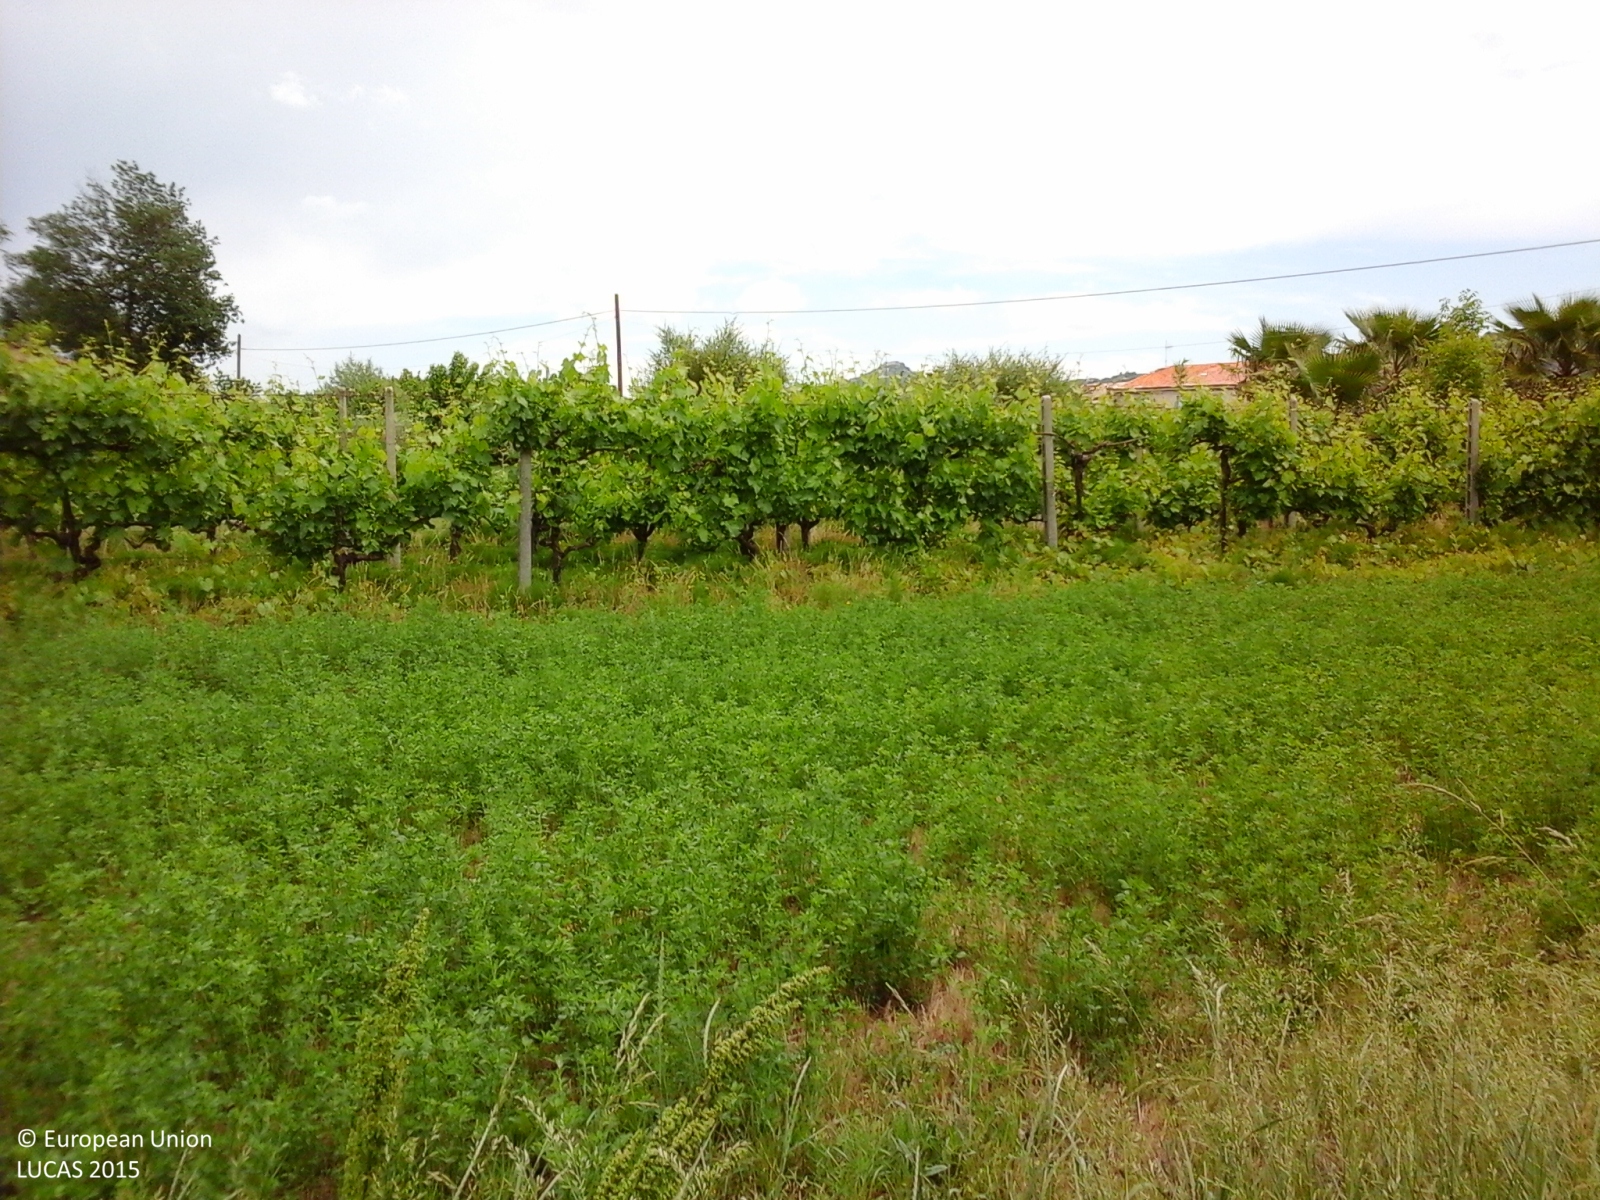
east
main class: Cropland
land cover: Nuts trees
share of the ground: > 75 %
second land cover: Grassland without tree/shrub cover
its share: > 75 %
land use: Agriculture (excluding fallow land and kitchen gardens)
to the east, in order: Nuts trees; Grassland without tree/shrub cover; Lucerne; Vineyards; Lines of trees; Grassland without tree/shrub cover; Lines of trees; Lucerne; Electric lines; Lucerne; Paved roads, cycling and walking lanes; Ditches and canals; Single bushes/trees; Grassland with sparse tree/shrub cover; Electric lines; Vineyards; Tracks; Ditches and canals; Olive groves; Lines of trees; Grassland without tree/shrub cover; Electric lines; Grassland without tree/shrub cover; Vineyards
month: May
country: IT
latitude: 42.8721
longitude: 13.7966
